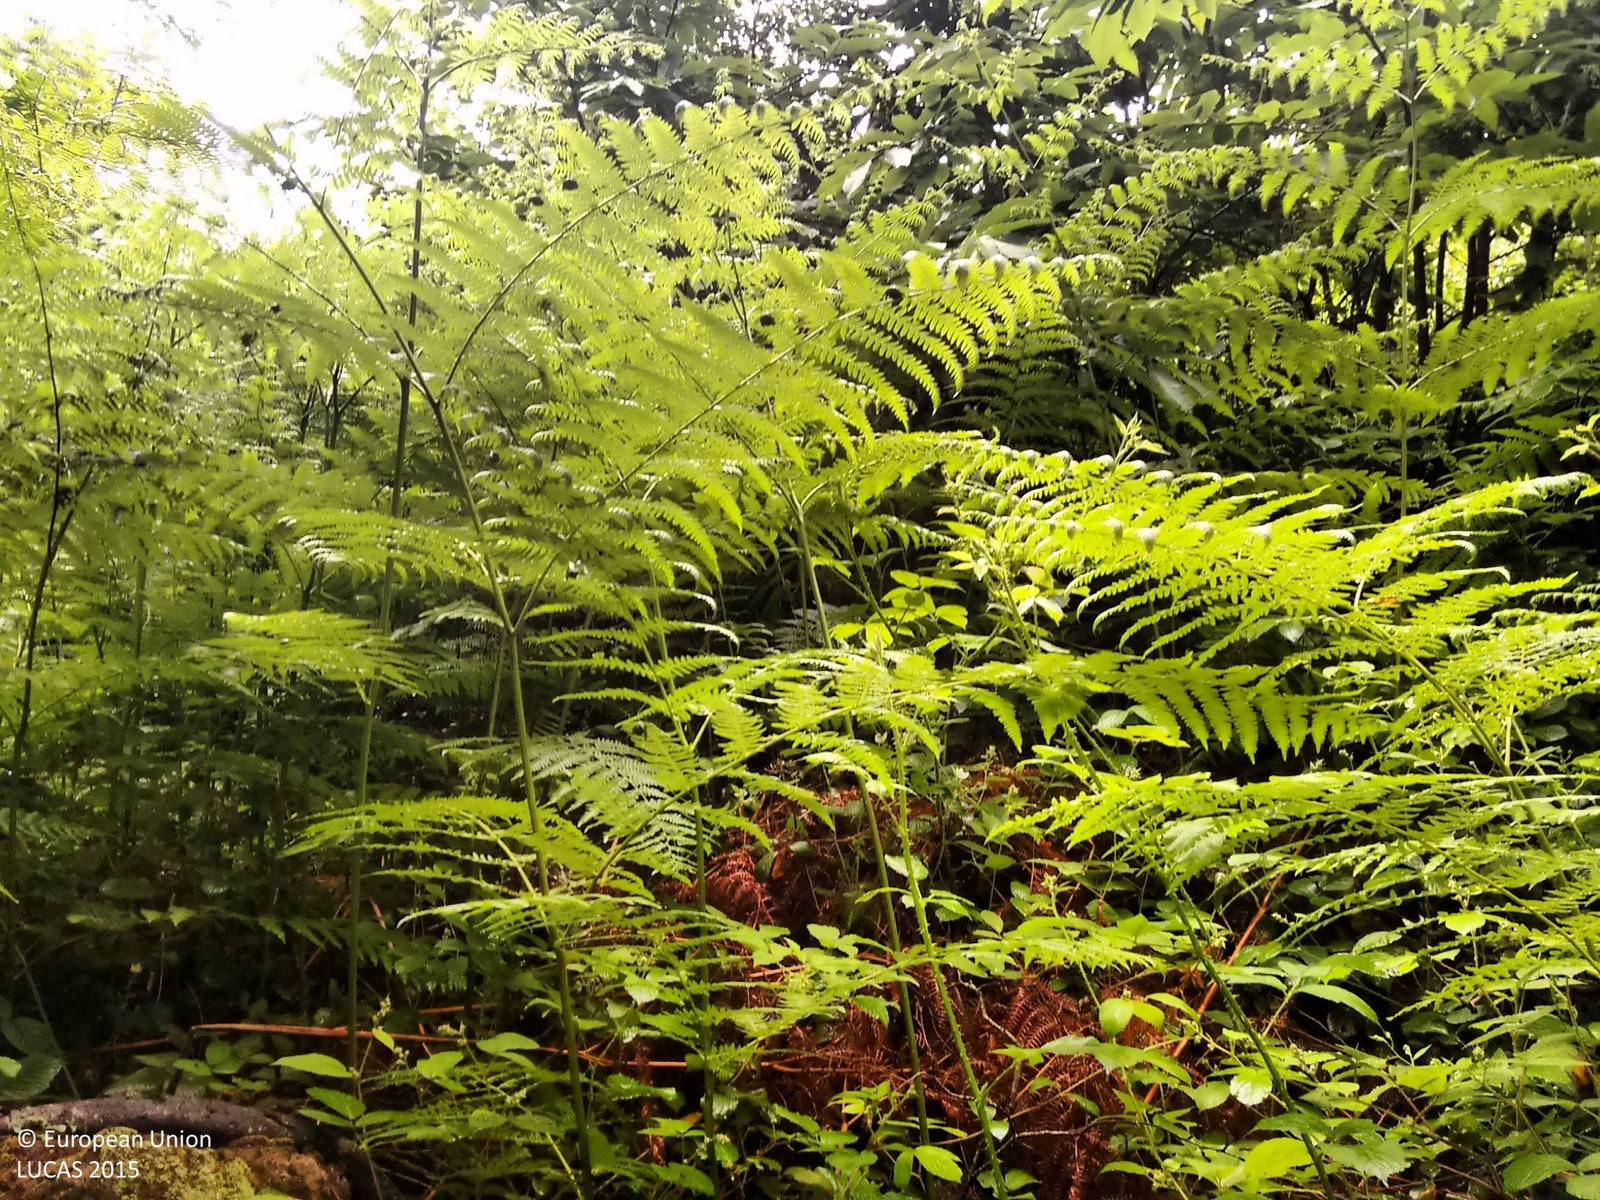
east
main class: Woodland
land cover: Broadleaved woodland
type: mesophytic deciduous forest
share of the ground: > 75 %
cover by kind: broadleaved forest trees 70 %, shrubs 30 %
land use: Forestry
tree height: > 5 m
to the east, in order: Broadleaved woodland; Other mixed woodland; Tracks; Other mixed woodland; Tracks; Broadleaved woodland
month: June
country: GB
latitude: 50.8858
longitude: 0.4335
